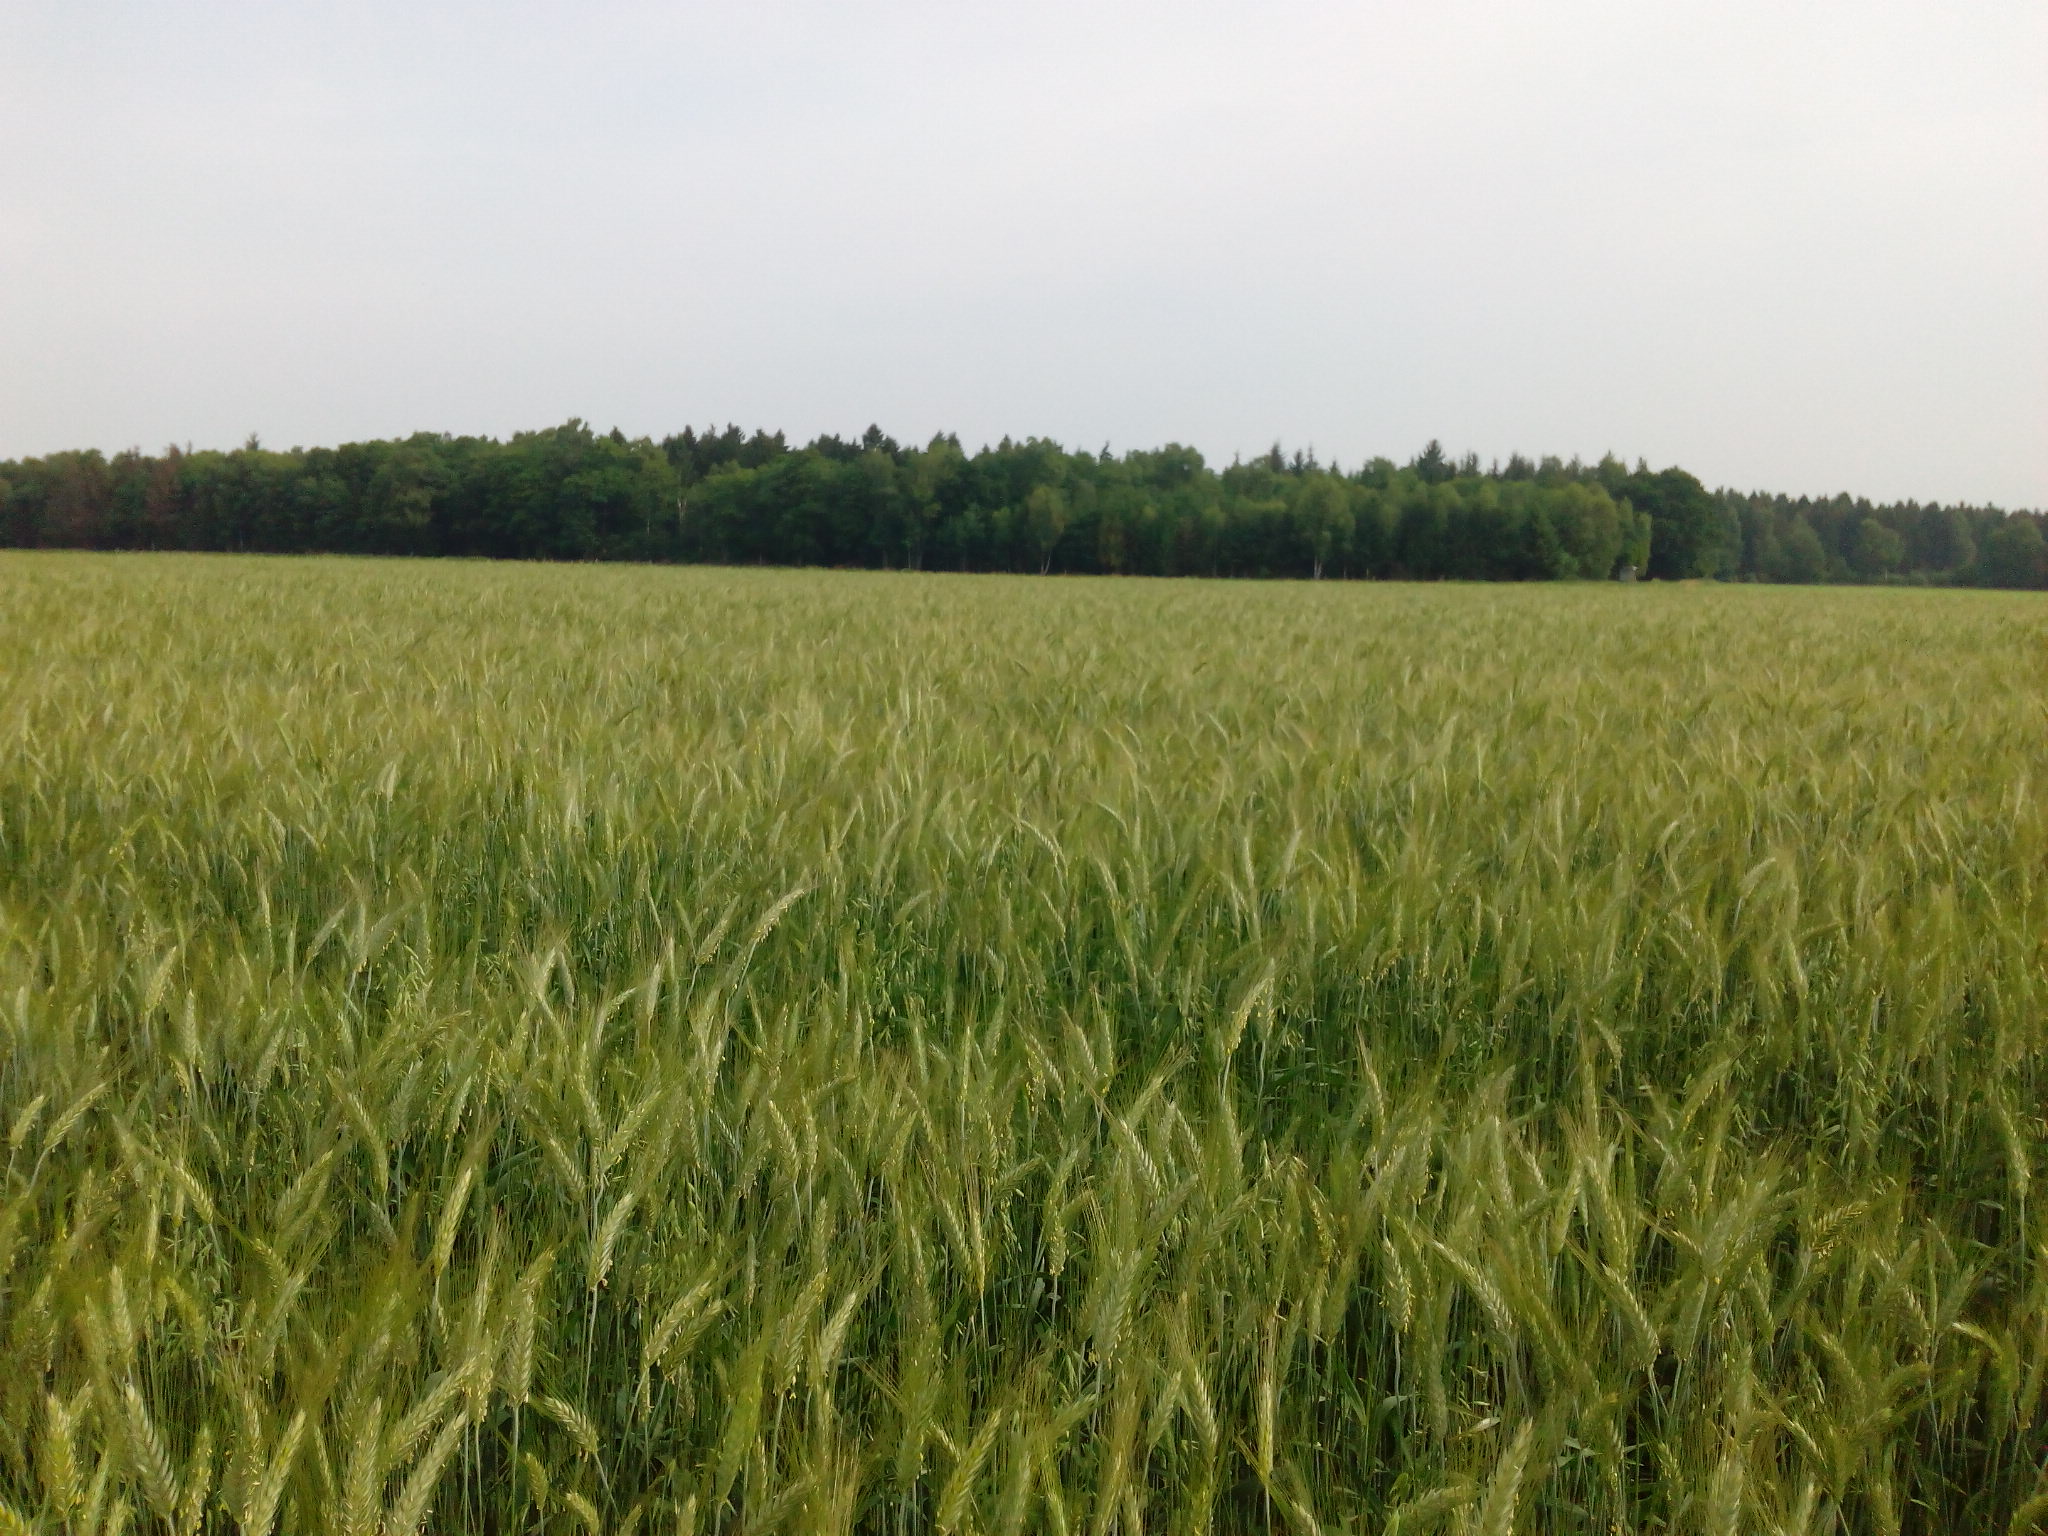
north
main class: Cropland
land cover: Rye
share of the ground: > 75 %
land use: Agriculture (excluding fallow land and kitchen gardens)
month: June
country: DE
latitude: 52.7543
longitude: 9.6297
